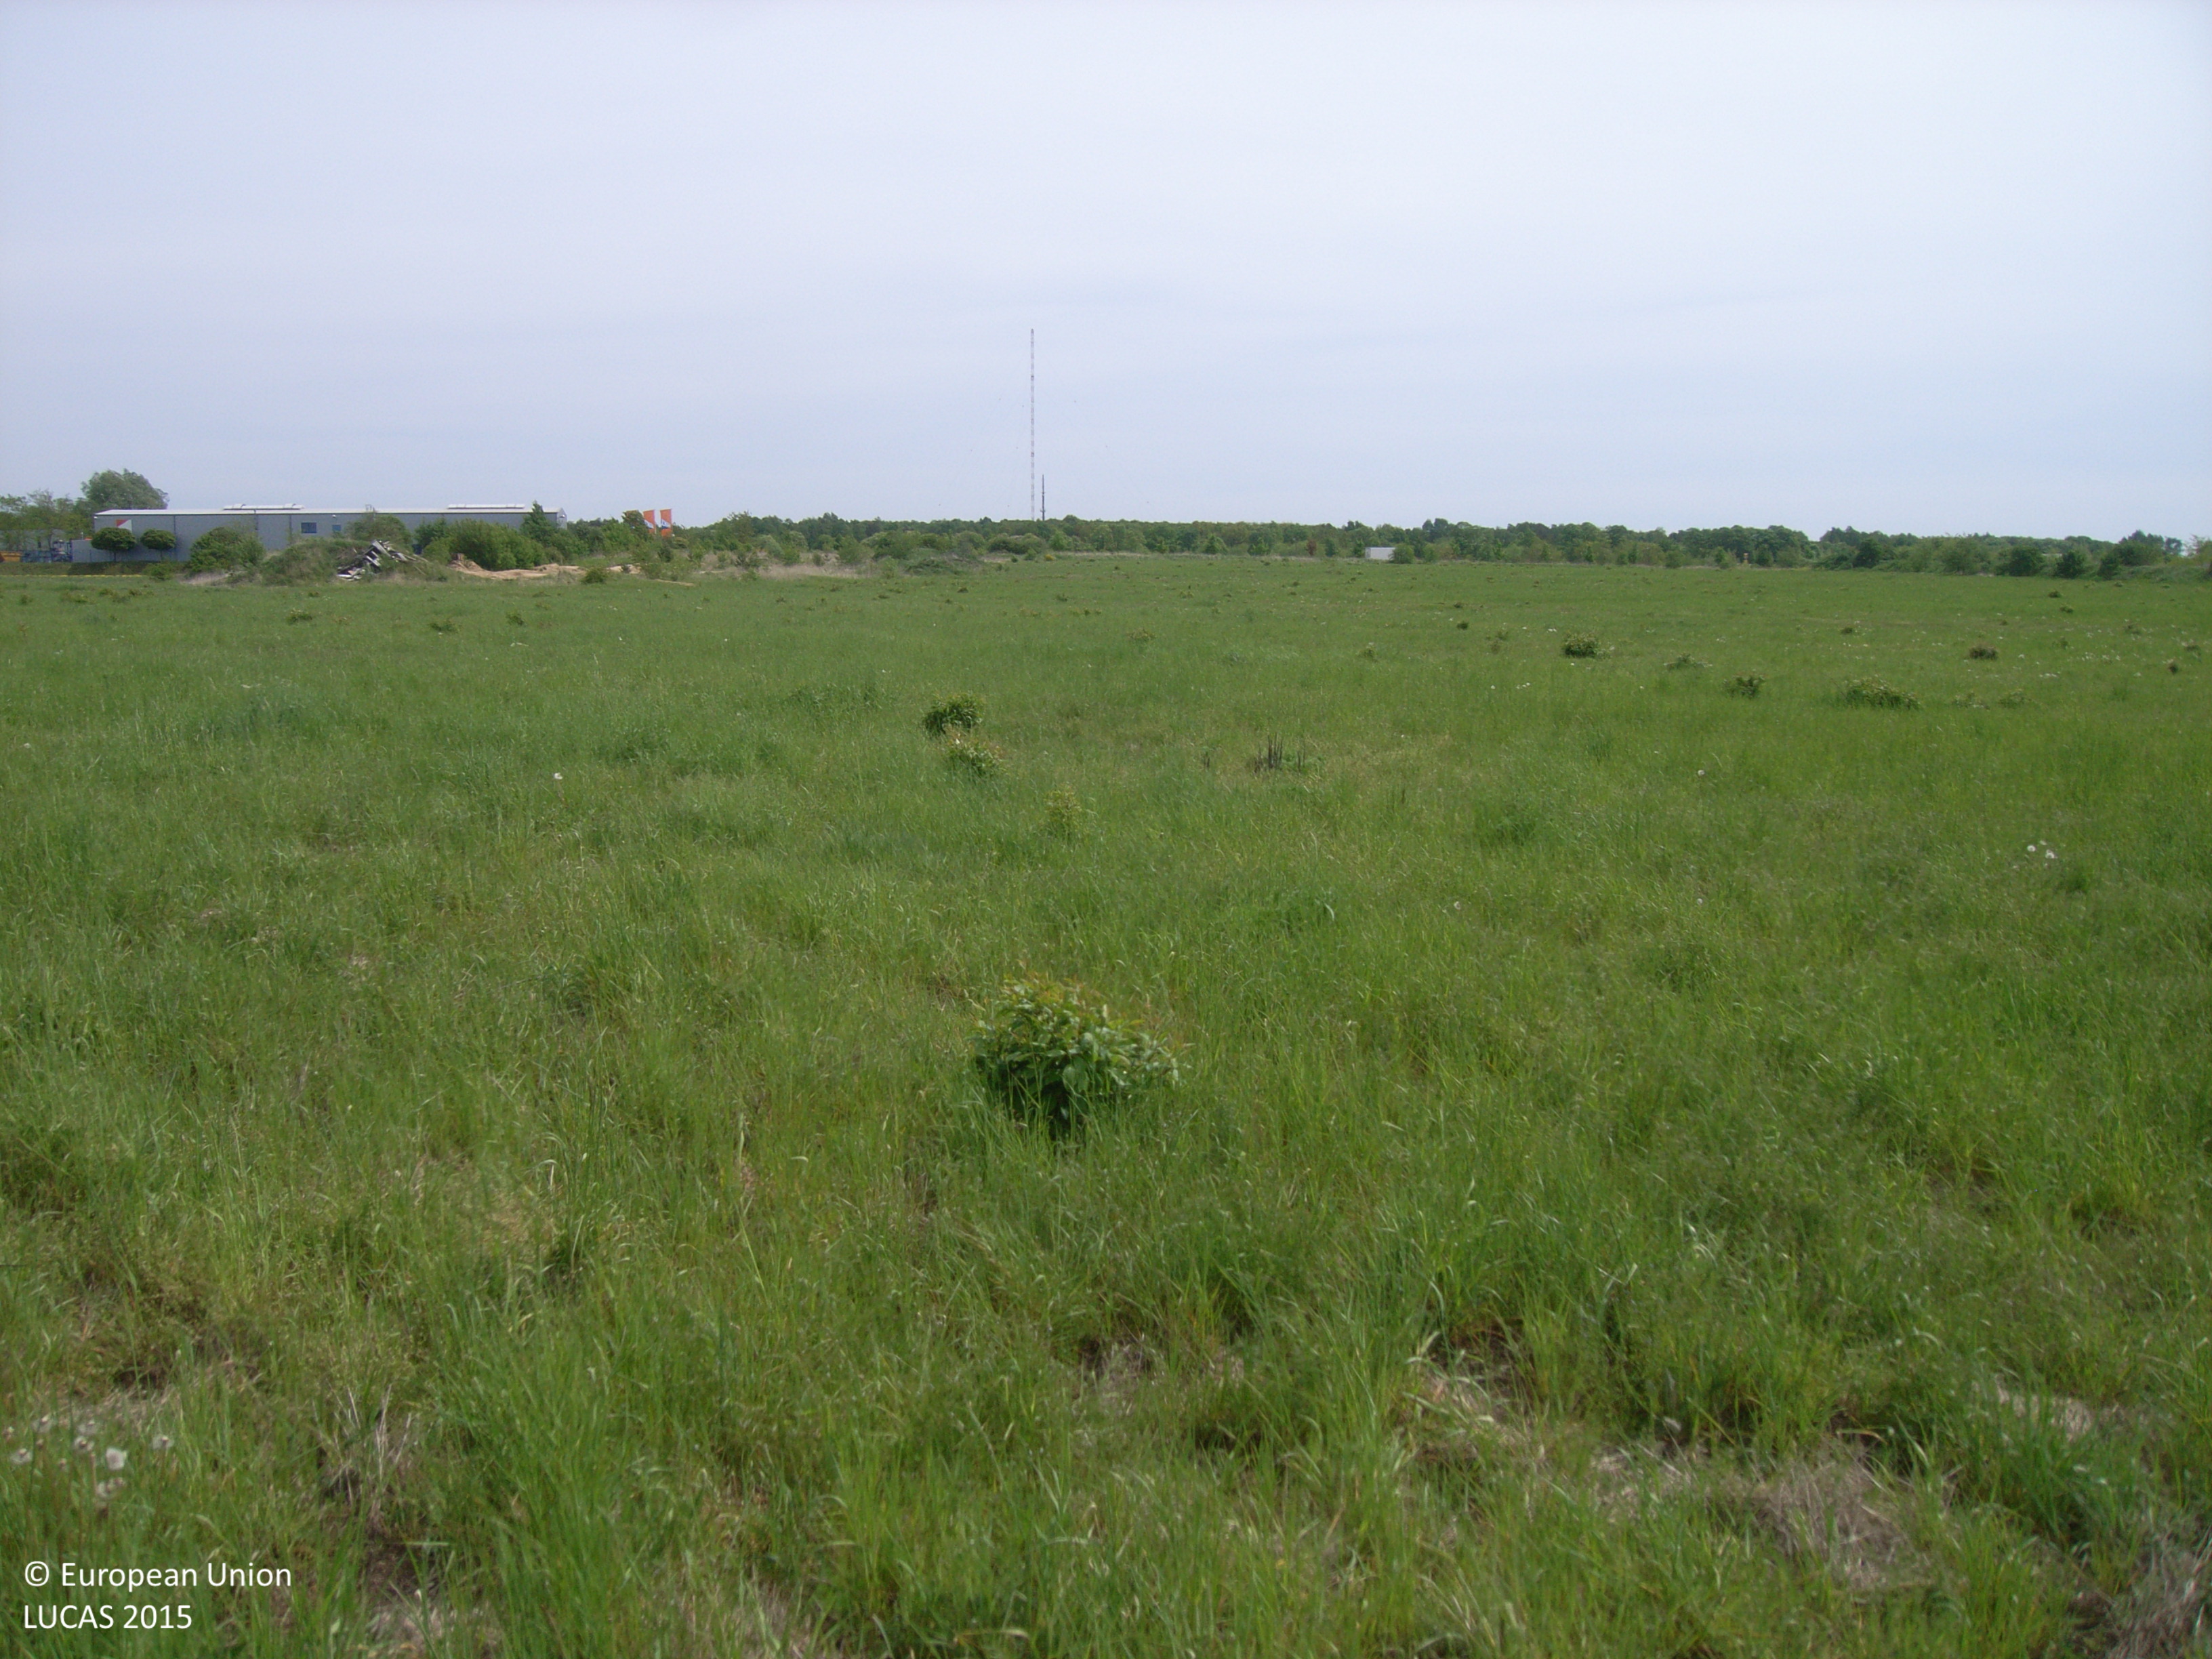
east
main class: Grassland
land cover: Grassland with sparse tree/shrub cover
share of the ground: > 75 %
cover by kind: herbaceous plants 95 %, broadleaved forest trees 5 %
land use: Abandoned areas
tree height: < 5 m
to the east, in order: Grassland with sparse tree/shrub cover
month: May
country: DE
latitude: 52.3051
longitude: 13.5935
